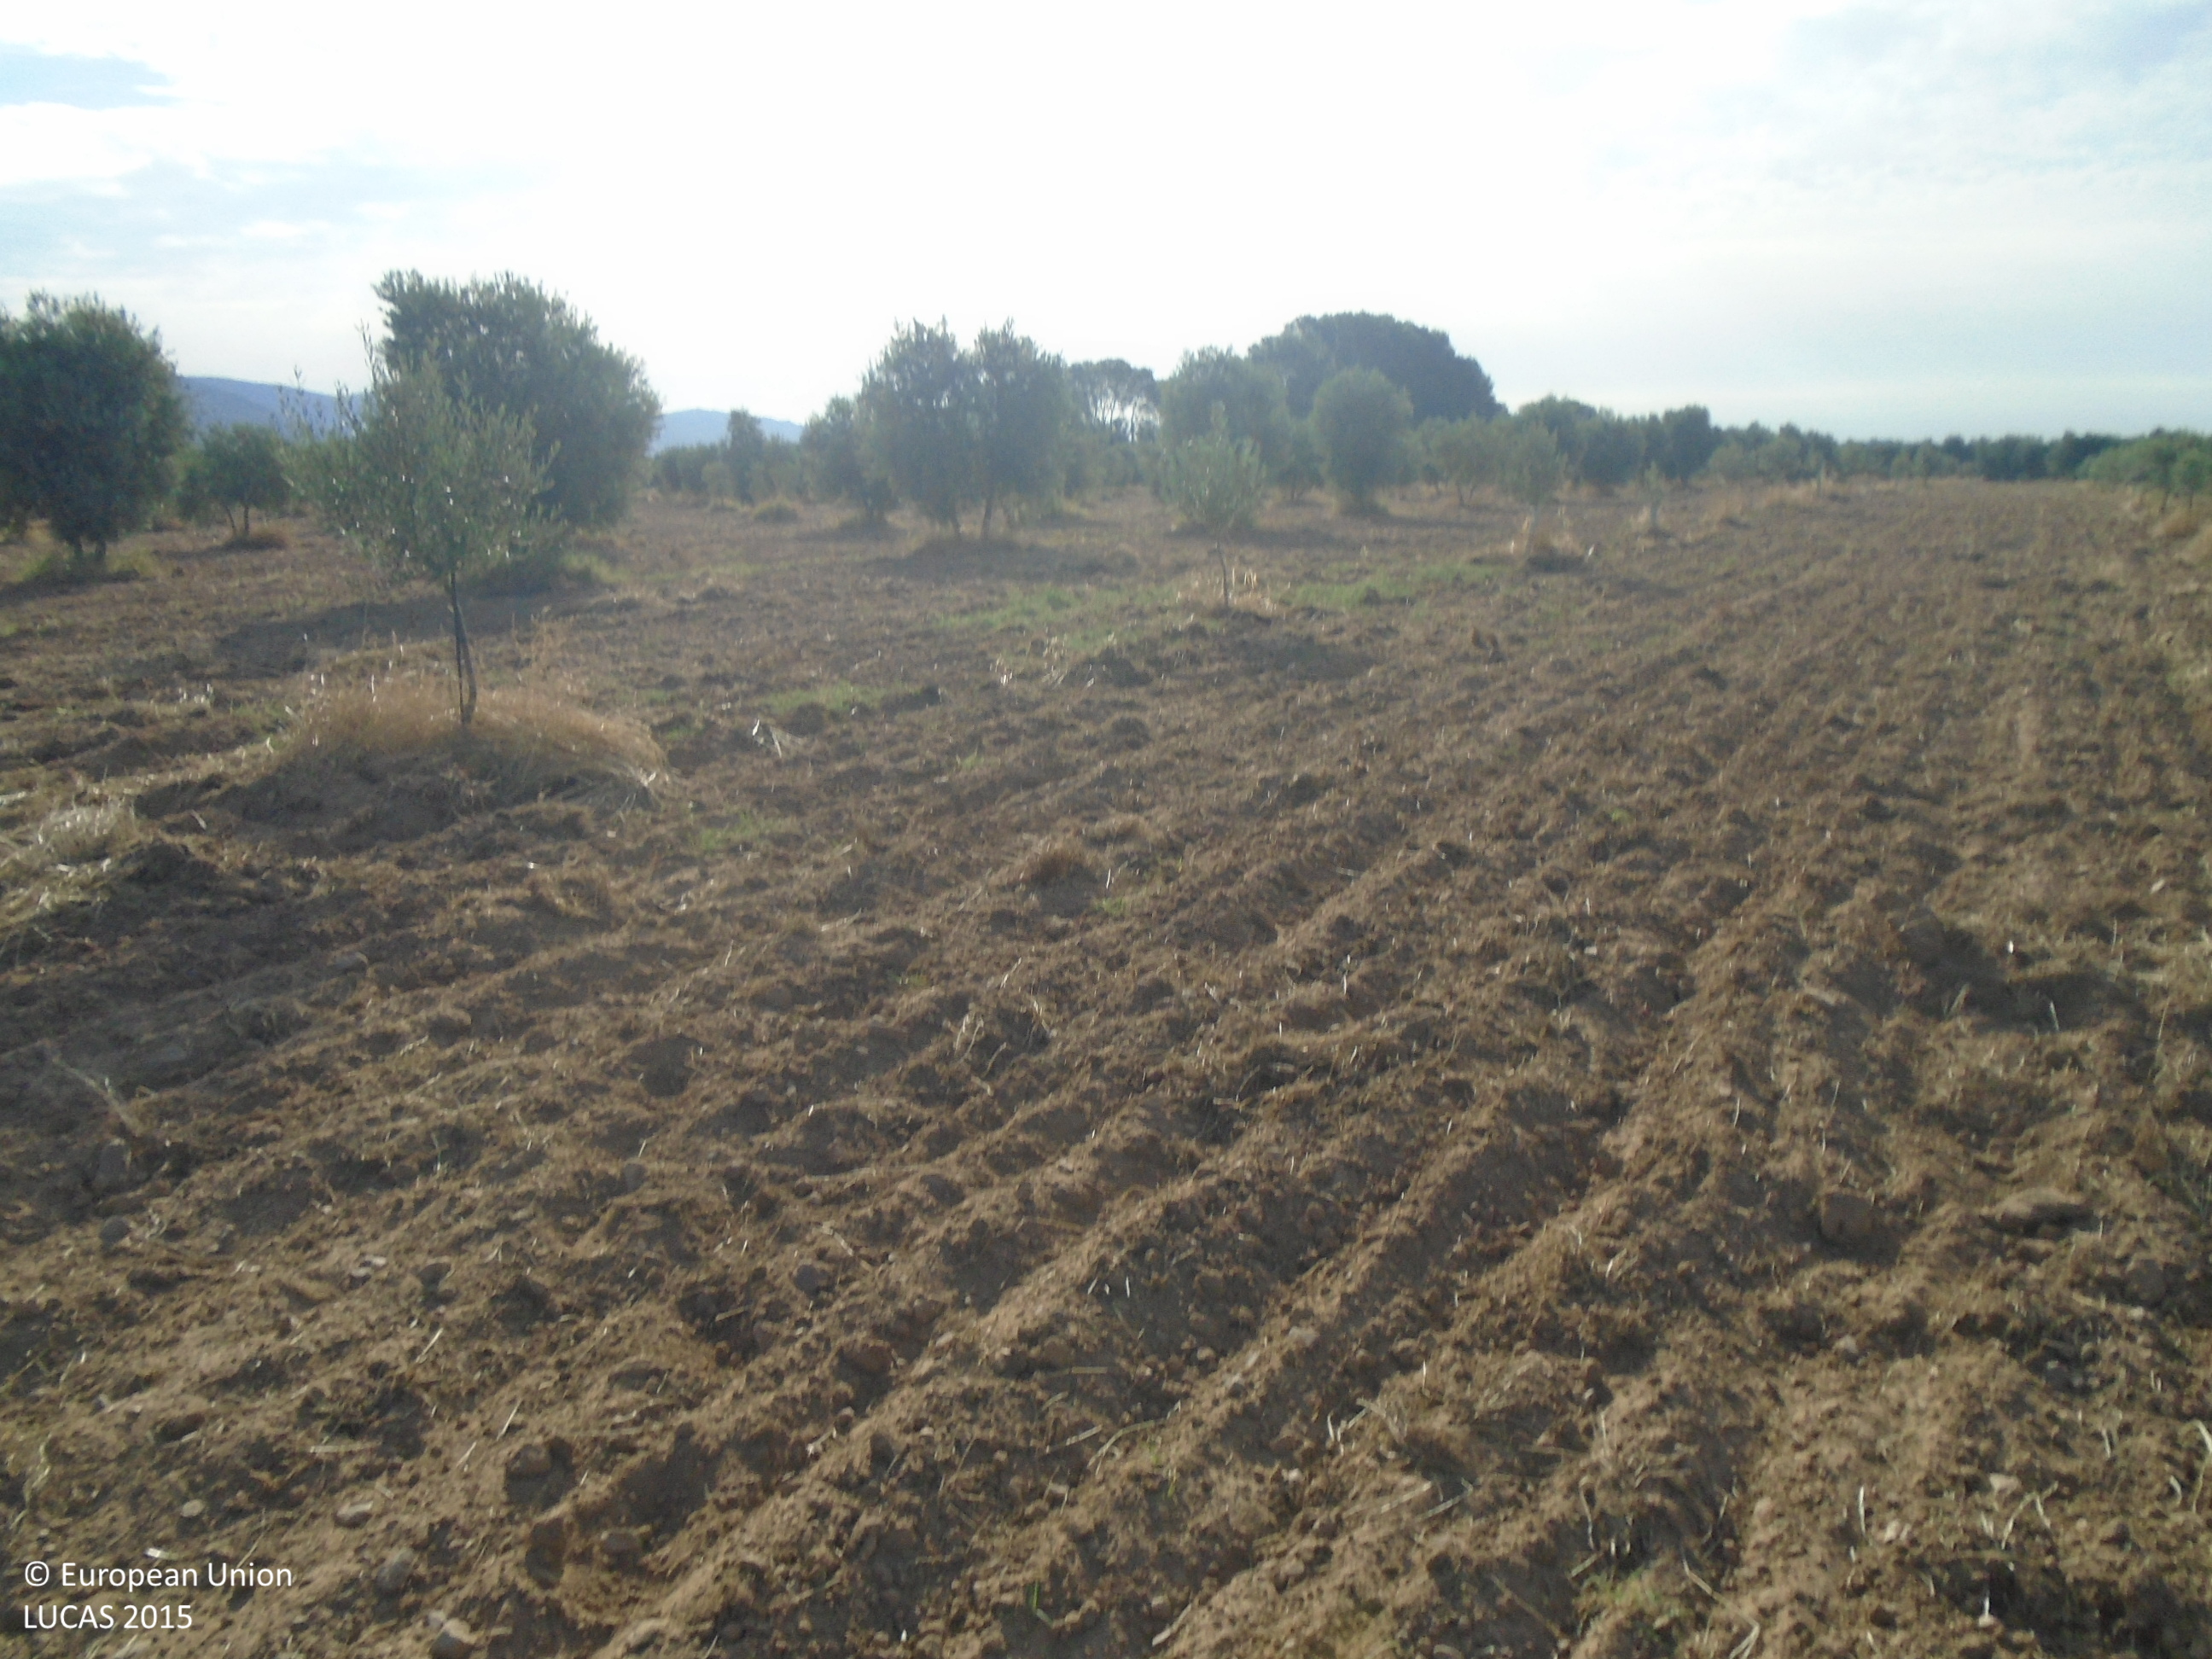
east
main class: Cropland
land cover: Olive groves
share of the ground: < 10 %
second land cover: Other bare soil
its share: > 75 %
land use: Agriculture (excluding fallow land and kitchen gardens)
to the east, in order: Olive groves; Other bare soil; Grass margins; Tracks; Grass margins; Olive groves; Grass margins; Tracks; Grass margins; Broadleaved woodland
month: July
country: ES
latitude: 39.1784
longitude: -4.0431
